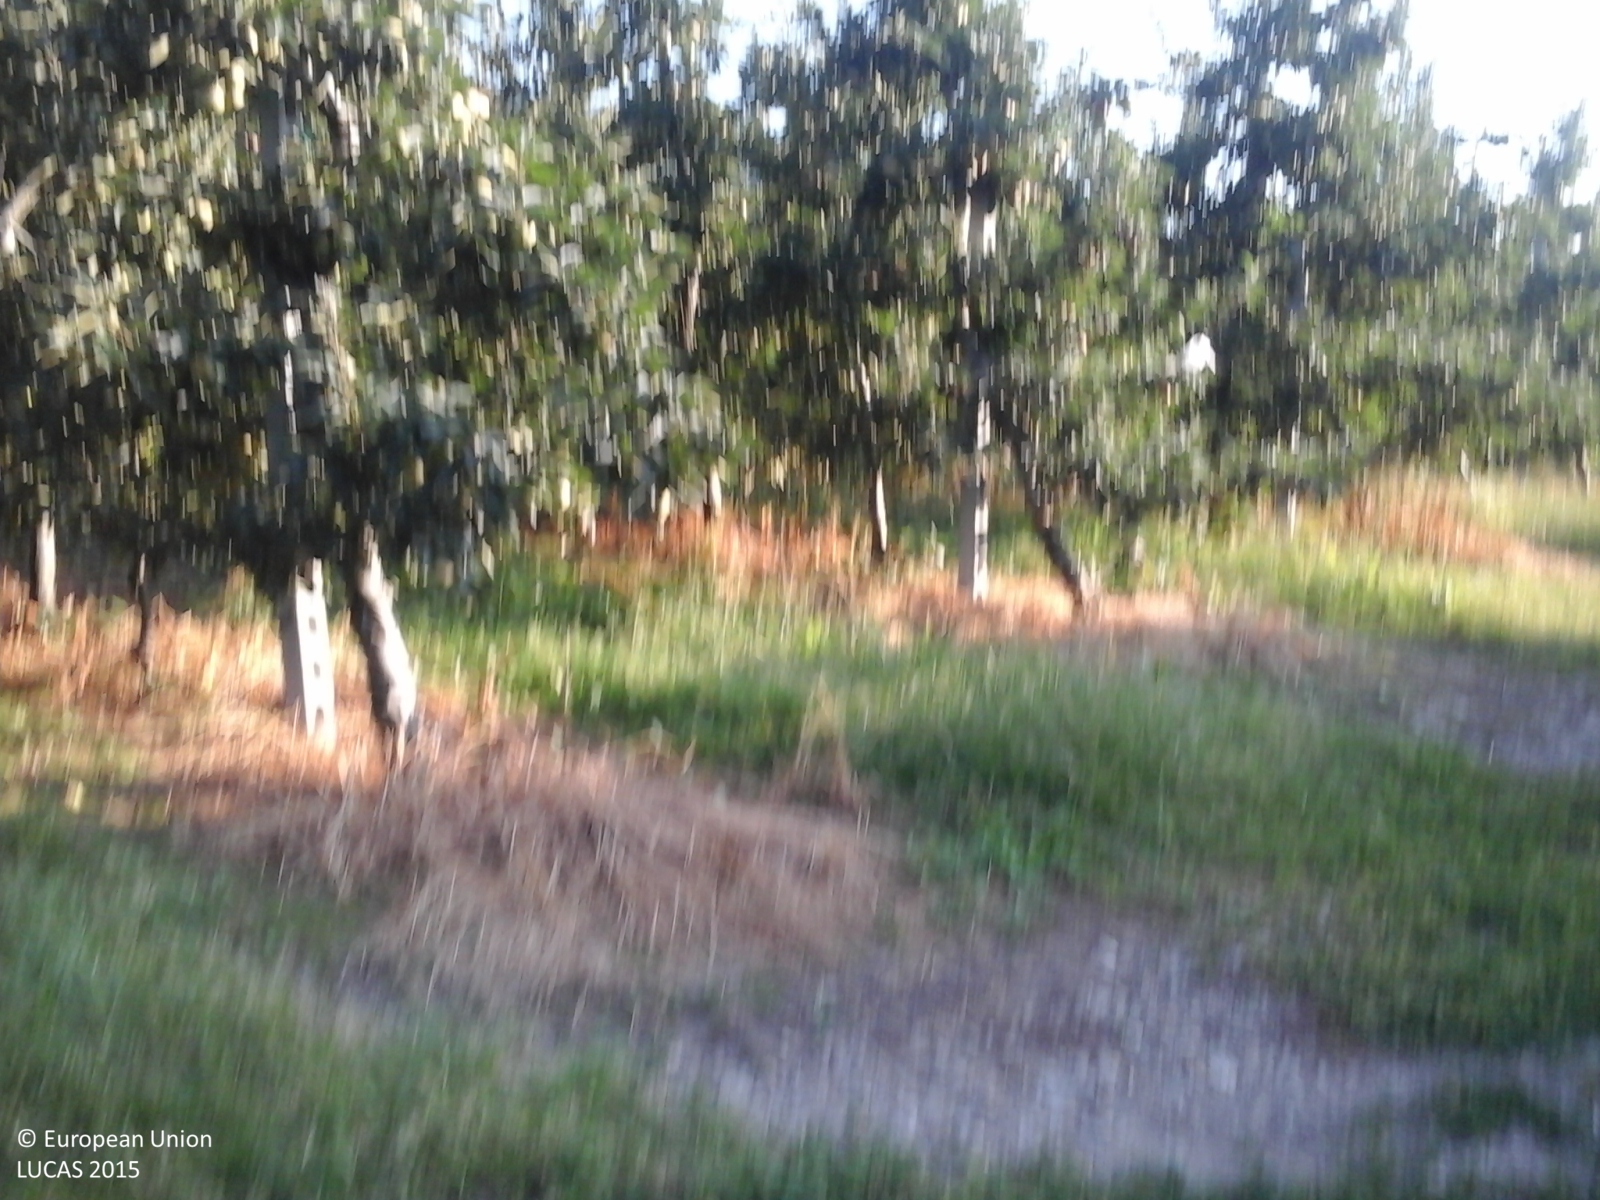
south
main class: Grassland
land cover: Grassland with sparse tree/shrub cover
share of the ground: > 75 %
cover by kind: herbaceous plants 85 %, shrubs 10 %, broadleaved forest trees 5 %
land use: Residential
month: July
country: IT
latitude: 46.2249
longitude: 10.1942
